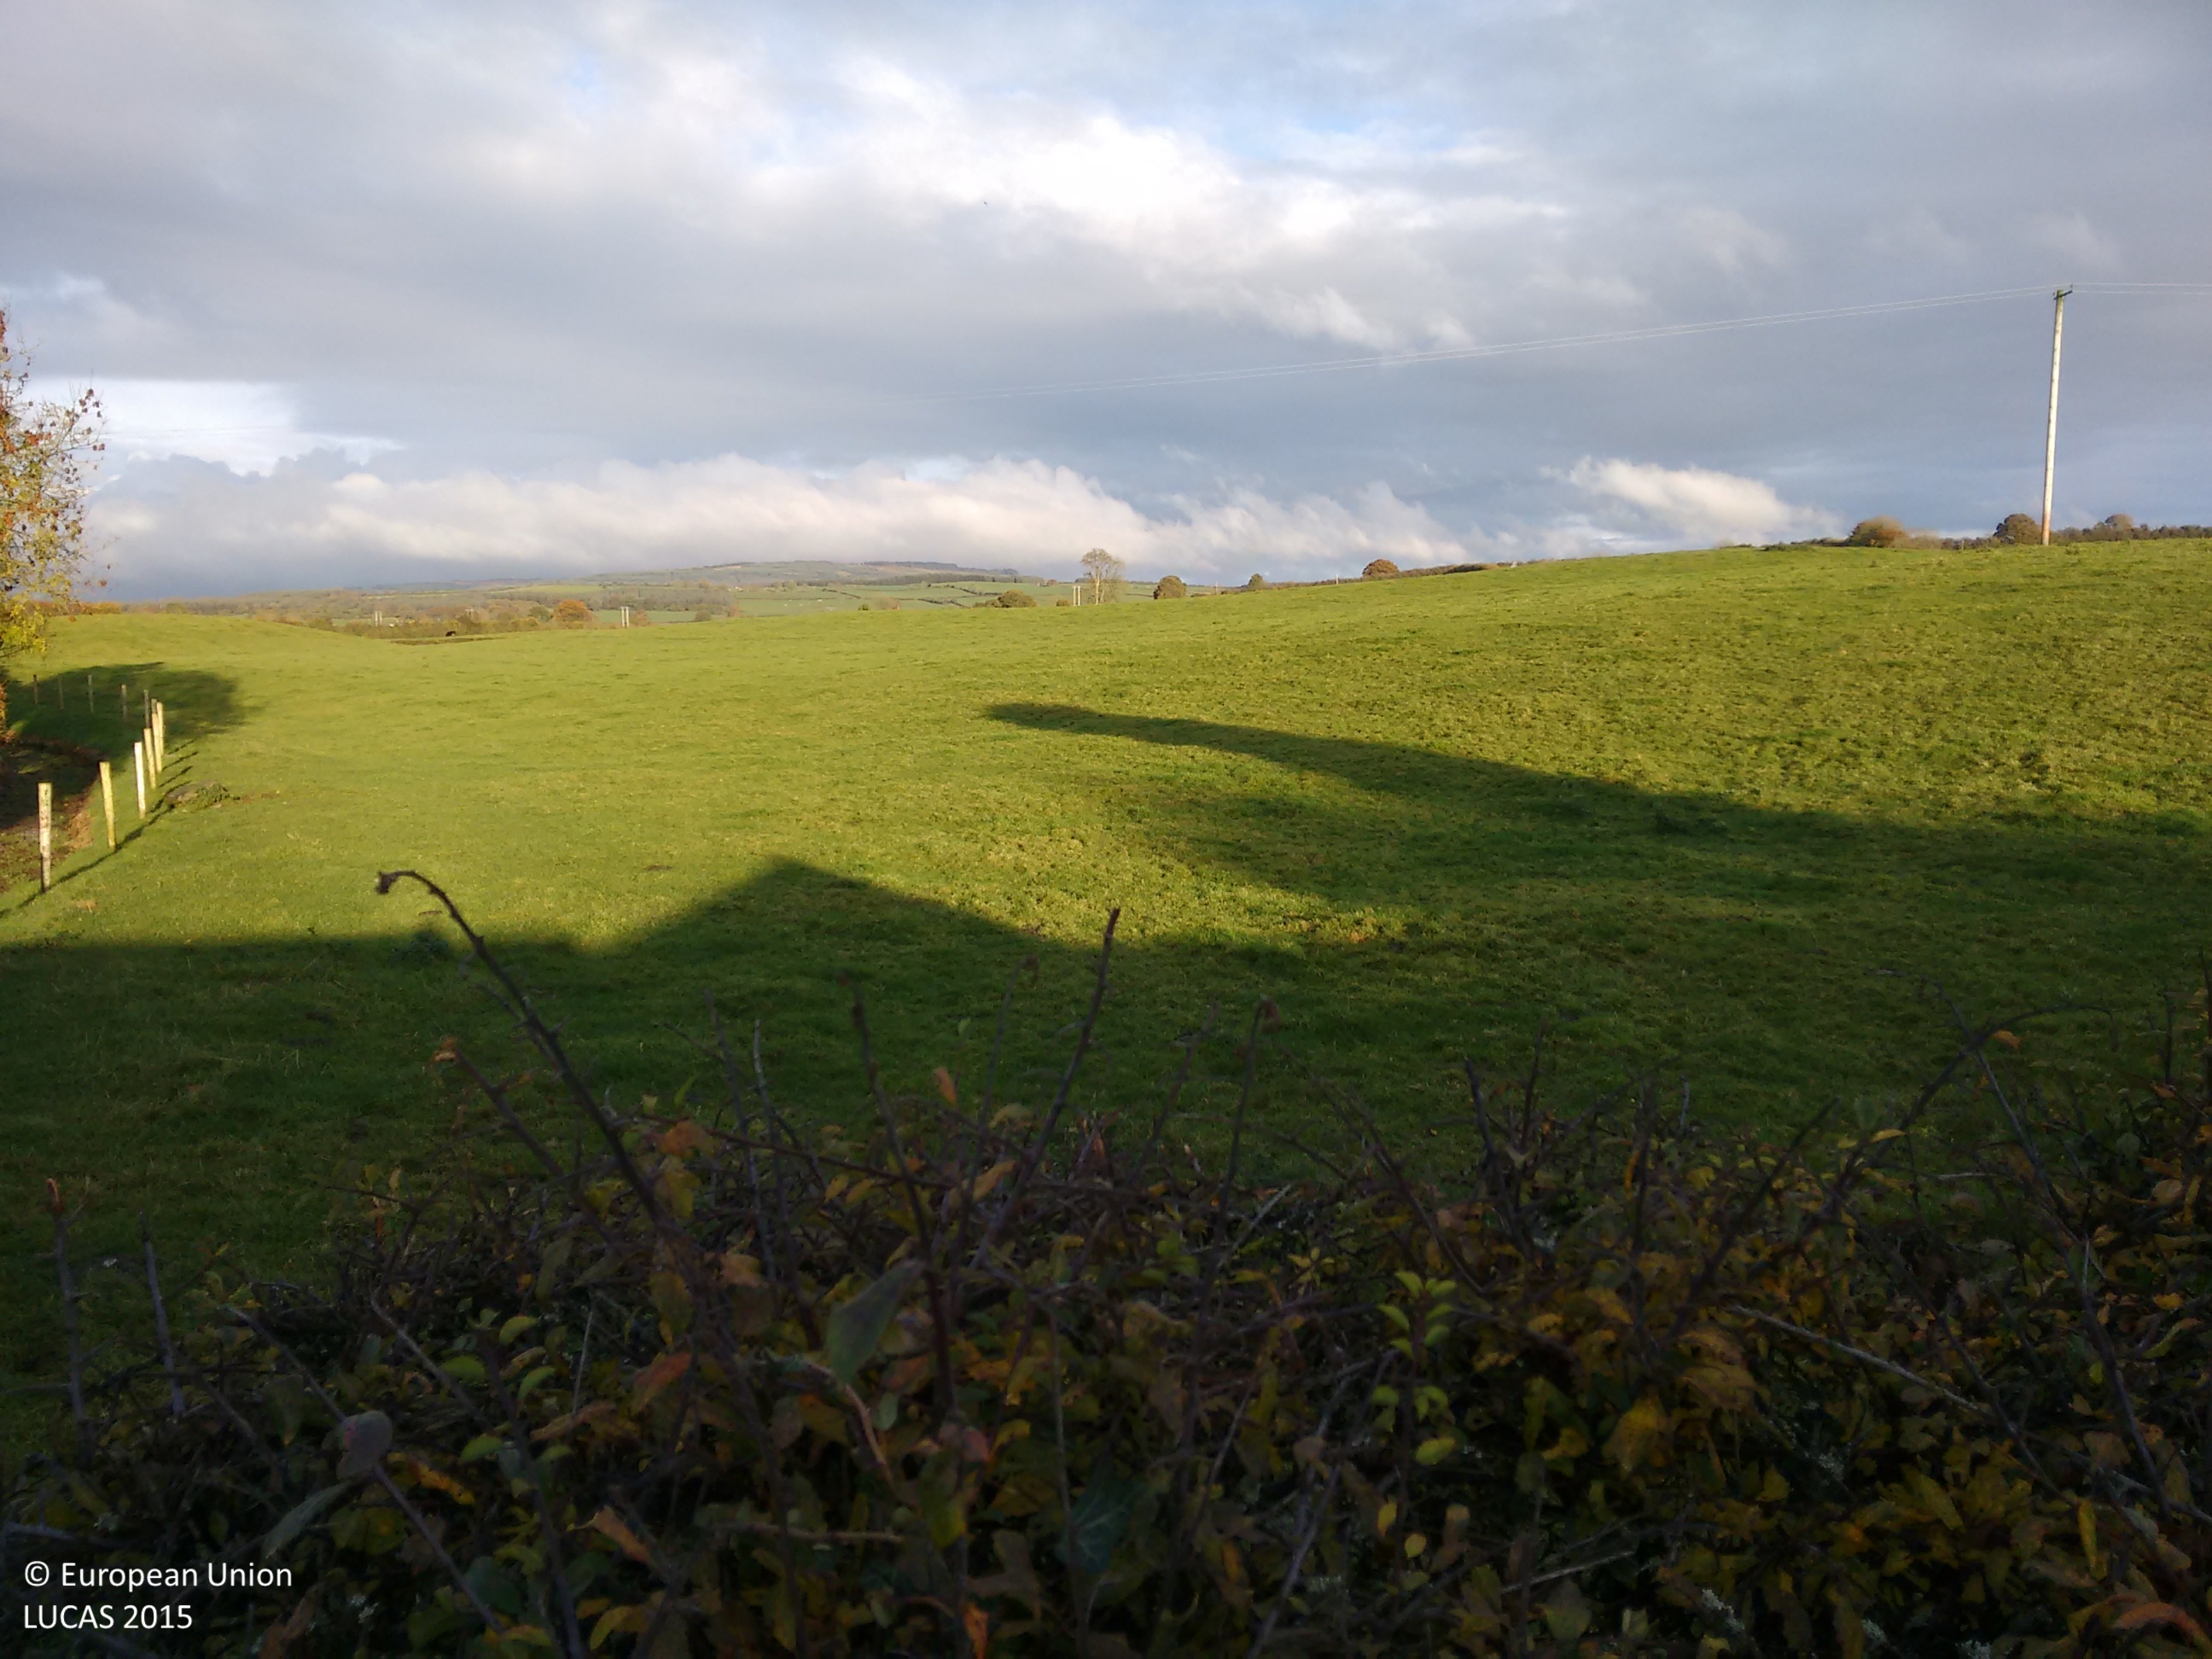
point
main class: Grassland
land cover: Grassland without tree/shrub cover
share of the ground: > 75 %
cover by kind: herbaceous plants 100 %
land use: Agriculture (excluding fallow land and kitchen gardens)
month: October
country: IE
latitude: 52.9904
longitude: -7.7920
